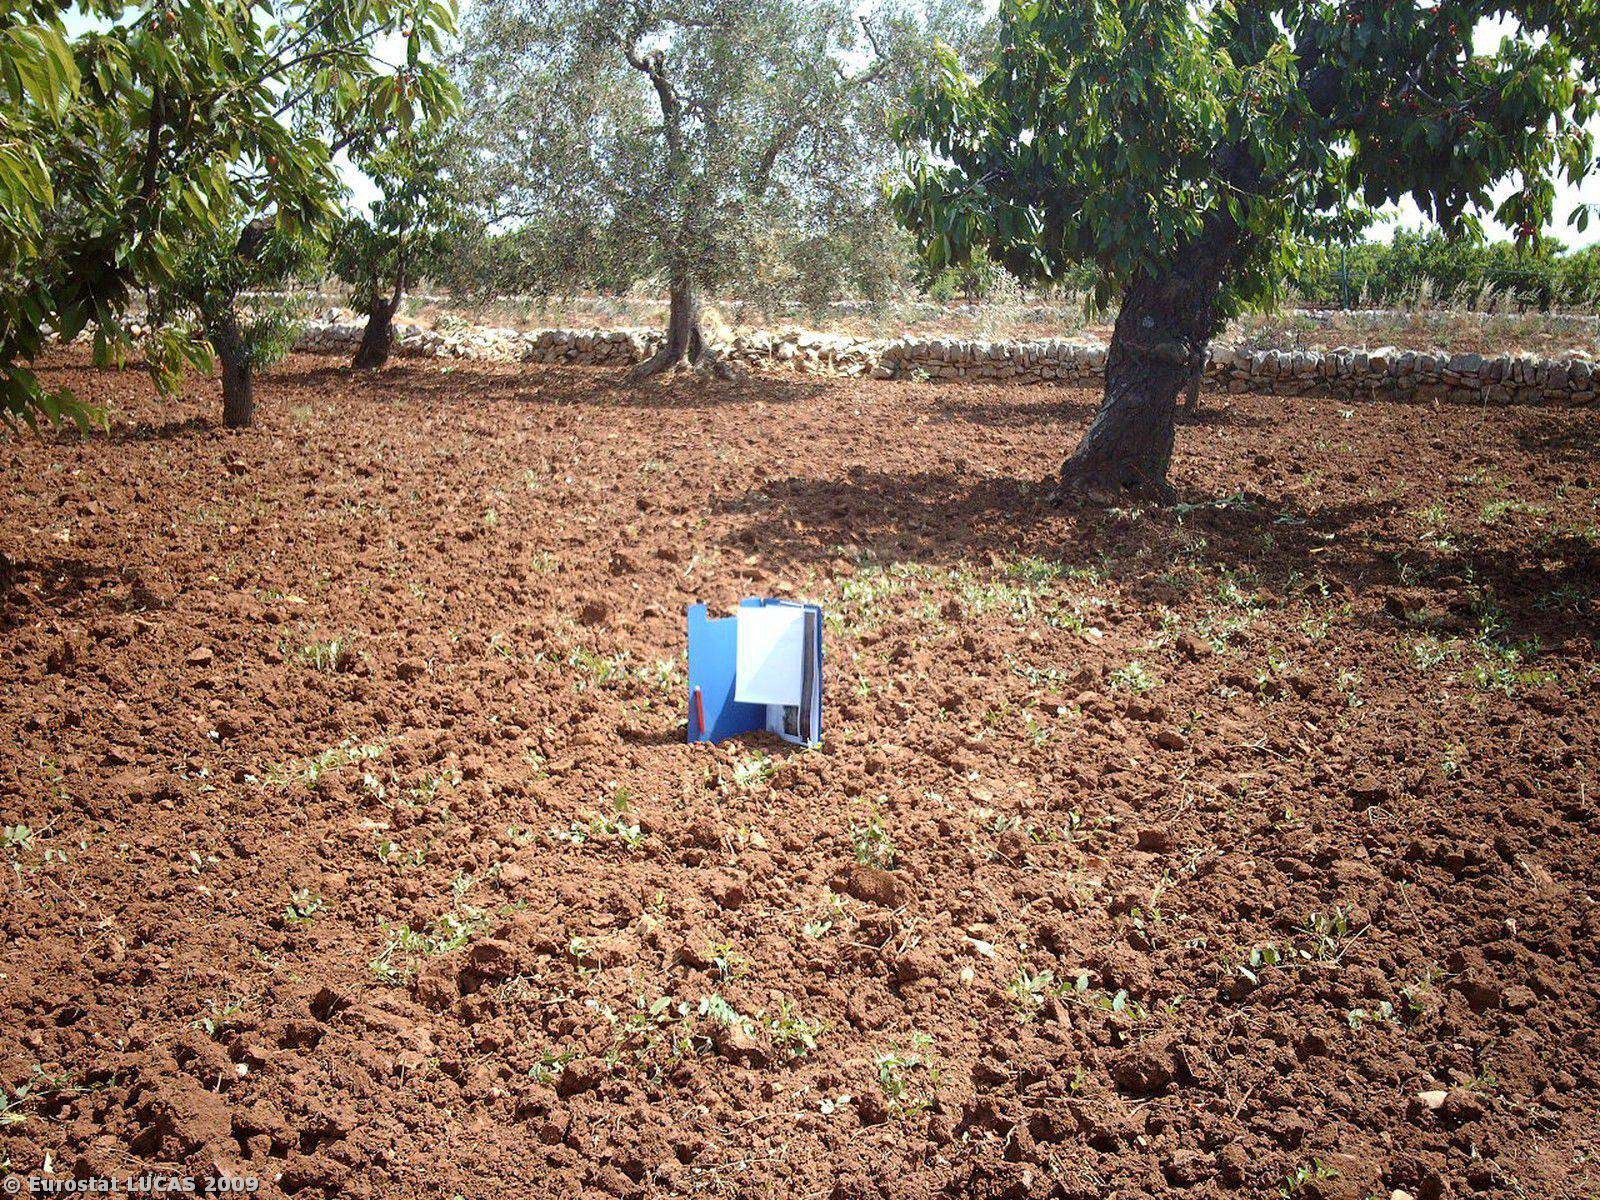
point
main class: Cropland
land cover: Cherry fruit
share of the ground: 50 - 75 %
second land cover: Olive groves
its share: 10 - 25 %
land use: Agriculture (excluding fallow land and kitchen gardens)
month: May
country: IT
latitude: 40.9070
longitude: 16.9944
